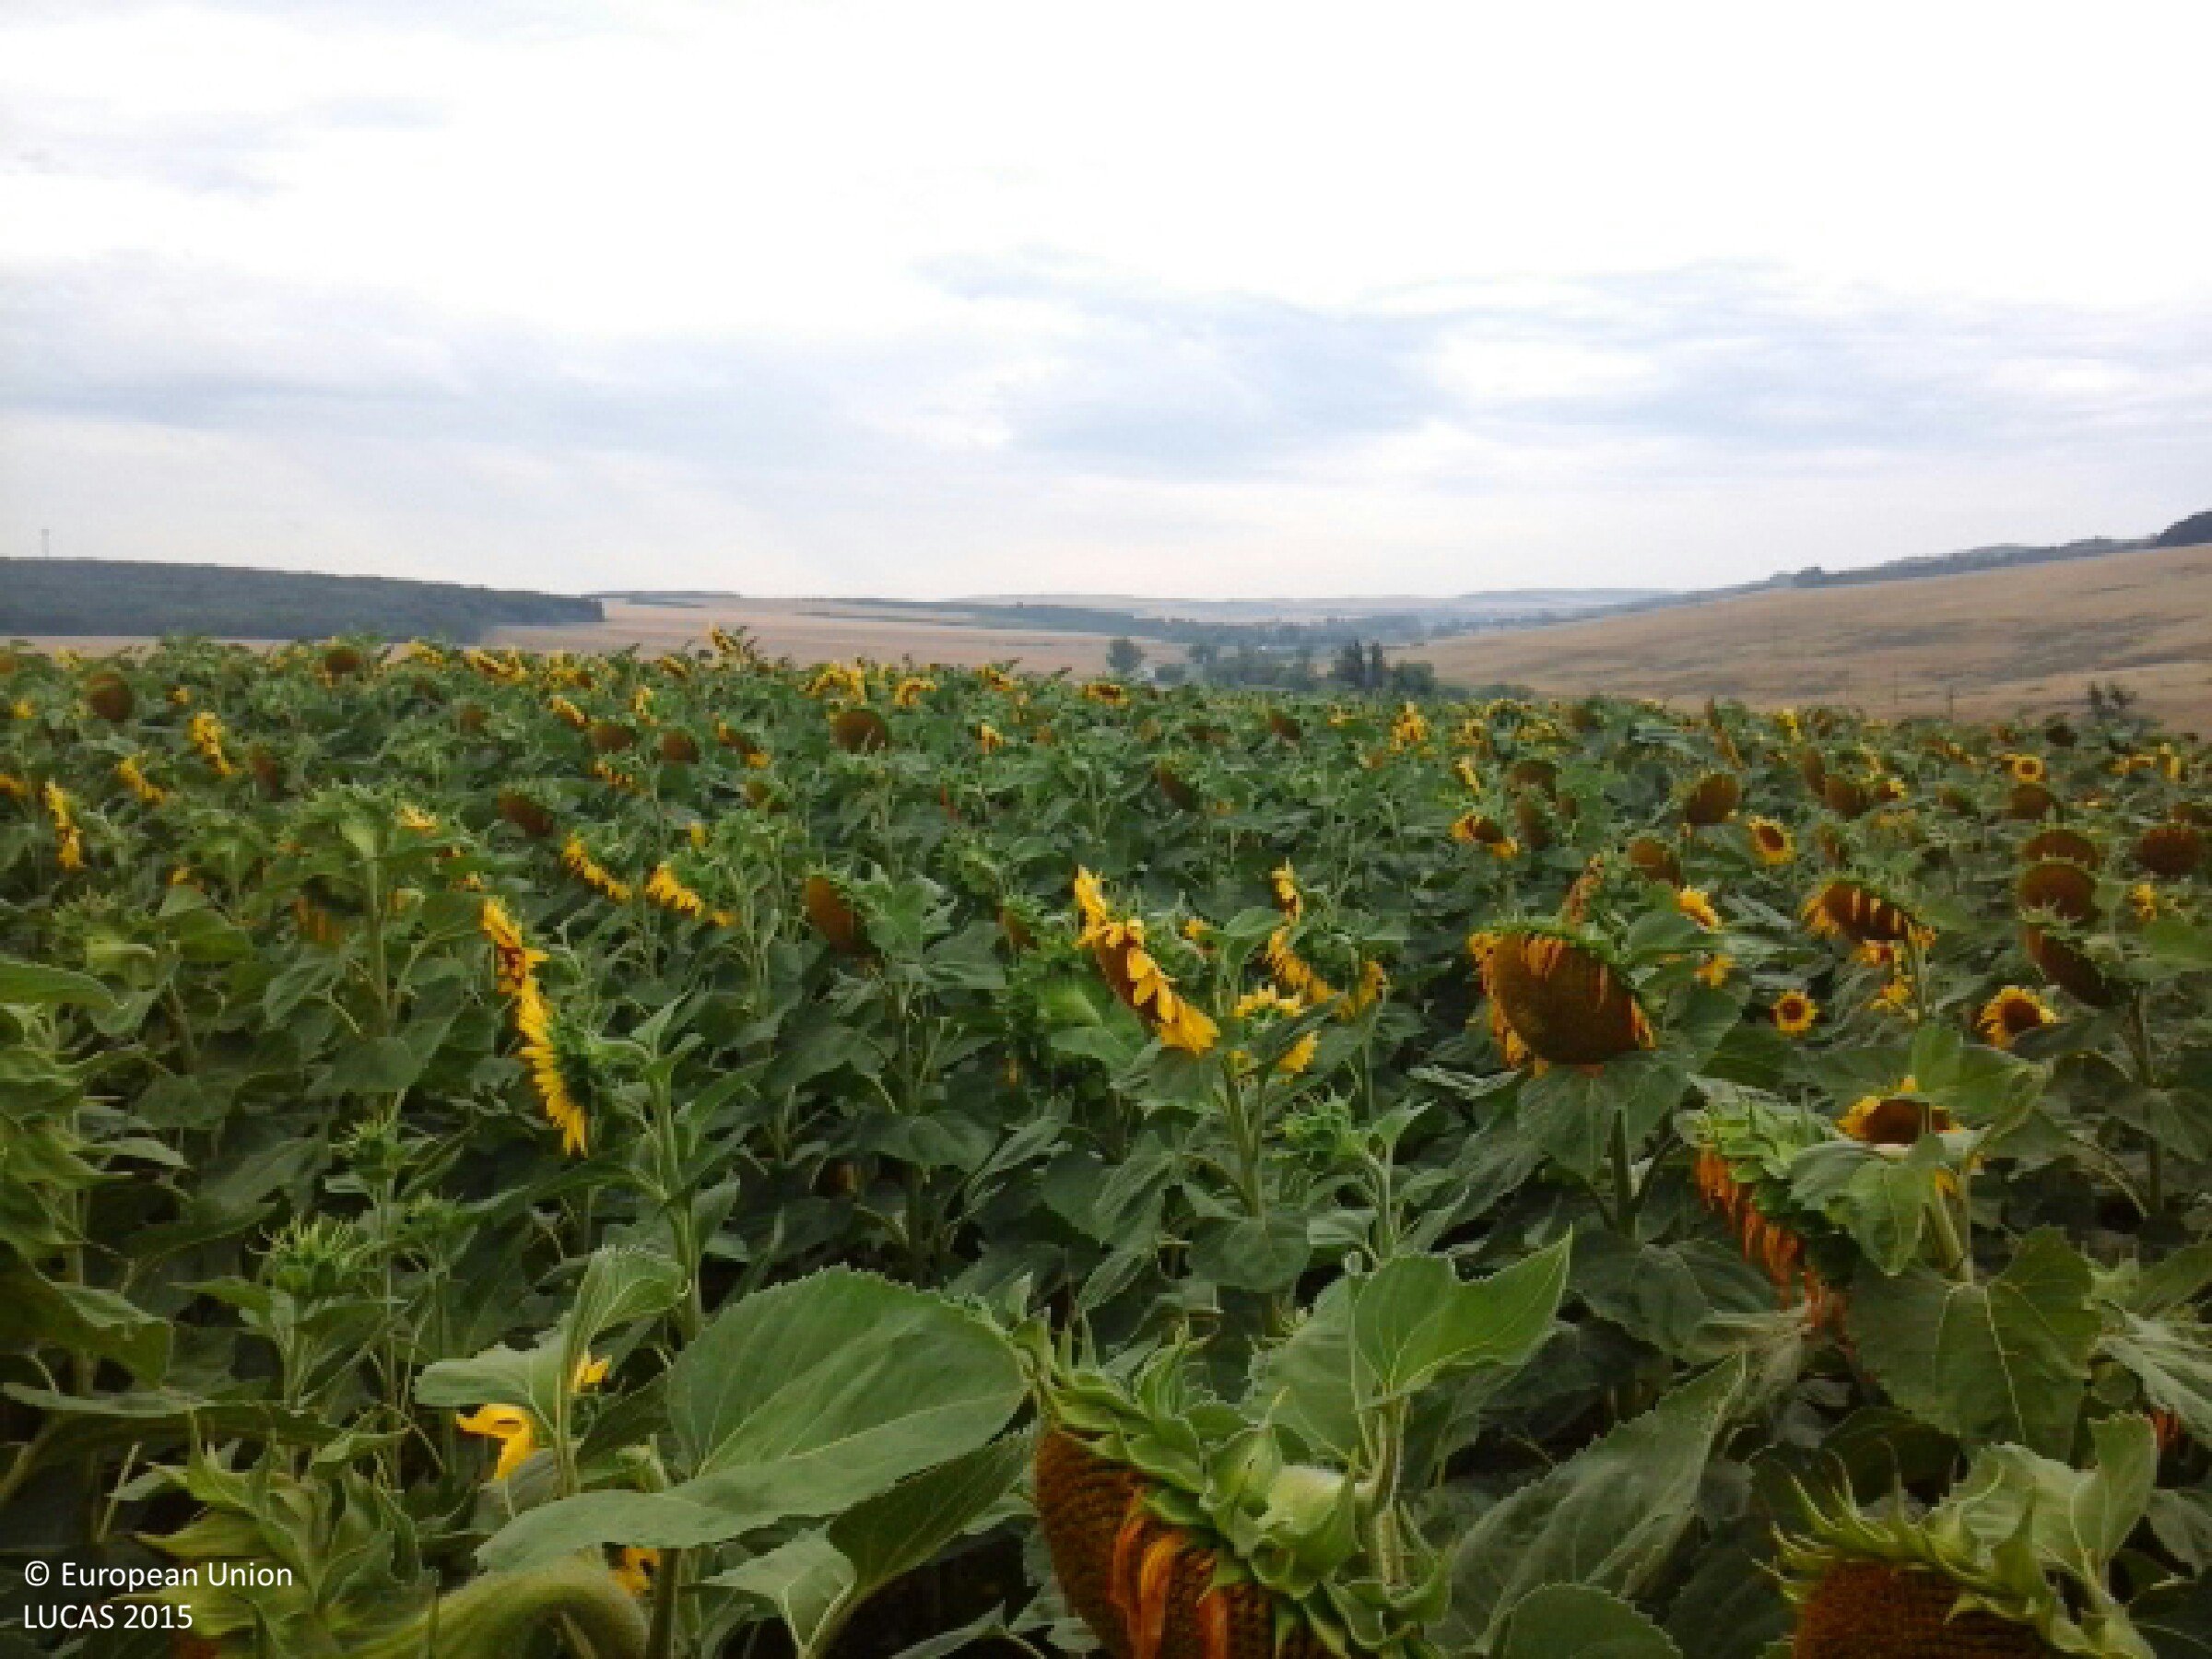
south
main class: Cropland
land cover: Sunflower
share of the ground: > 75 %
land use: Agriculture (excluding fallow land and kitchen gardens)
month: July
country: HU
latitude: 48.3653
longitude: 20.9596
